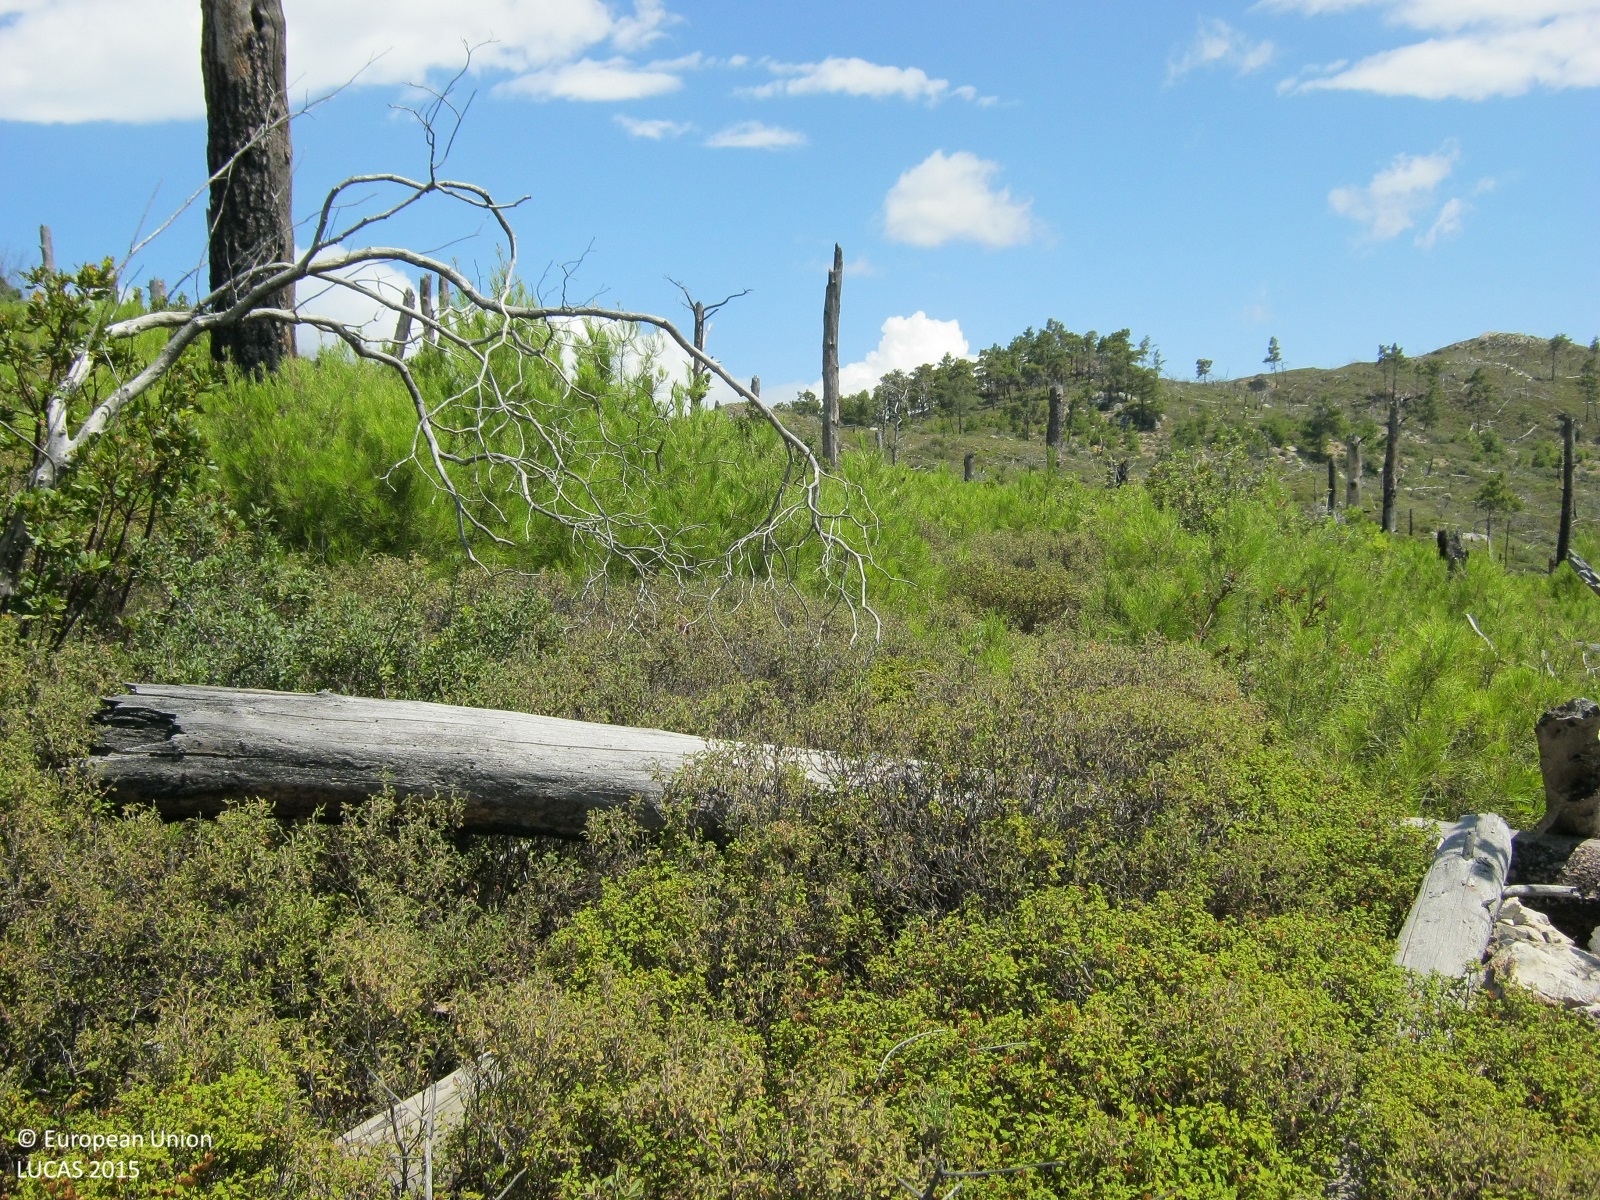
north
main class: Shrubland
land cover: Shrubland with sparse tree cover
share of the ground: > 75 %
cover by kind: shrubs 95 %, coniferous forest trees 5 %
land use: Semi-natural and natural areas not in use
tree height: < 5 m
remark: Burnt area
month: June
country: GR
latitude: 36.1164
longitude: 27.9535
